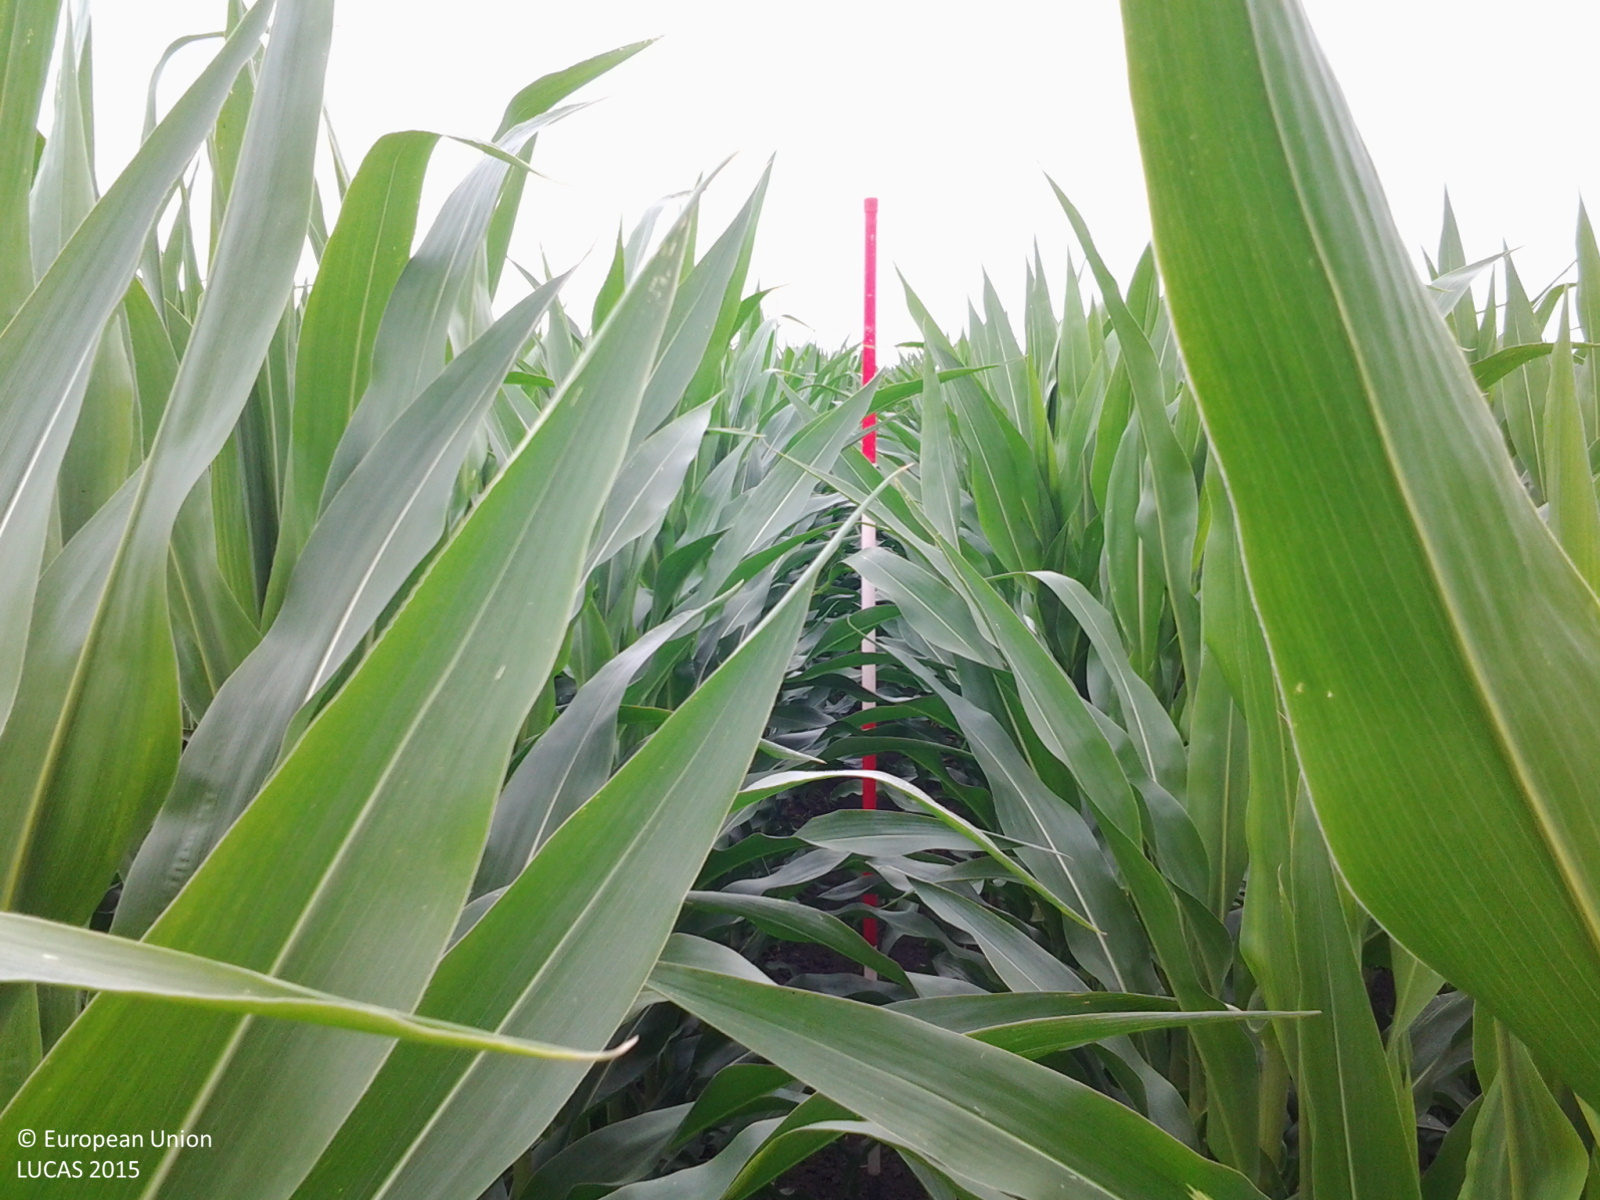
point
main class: Cropland
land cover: Maize
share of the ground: > 75 %
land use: Agriculture (excluding fallow land and kitchen gardens)
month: June
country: HU
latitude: 46.4020
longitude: 21.1541
